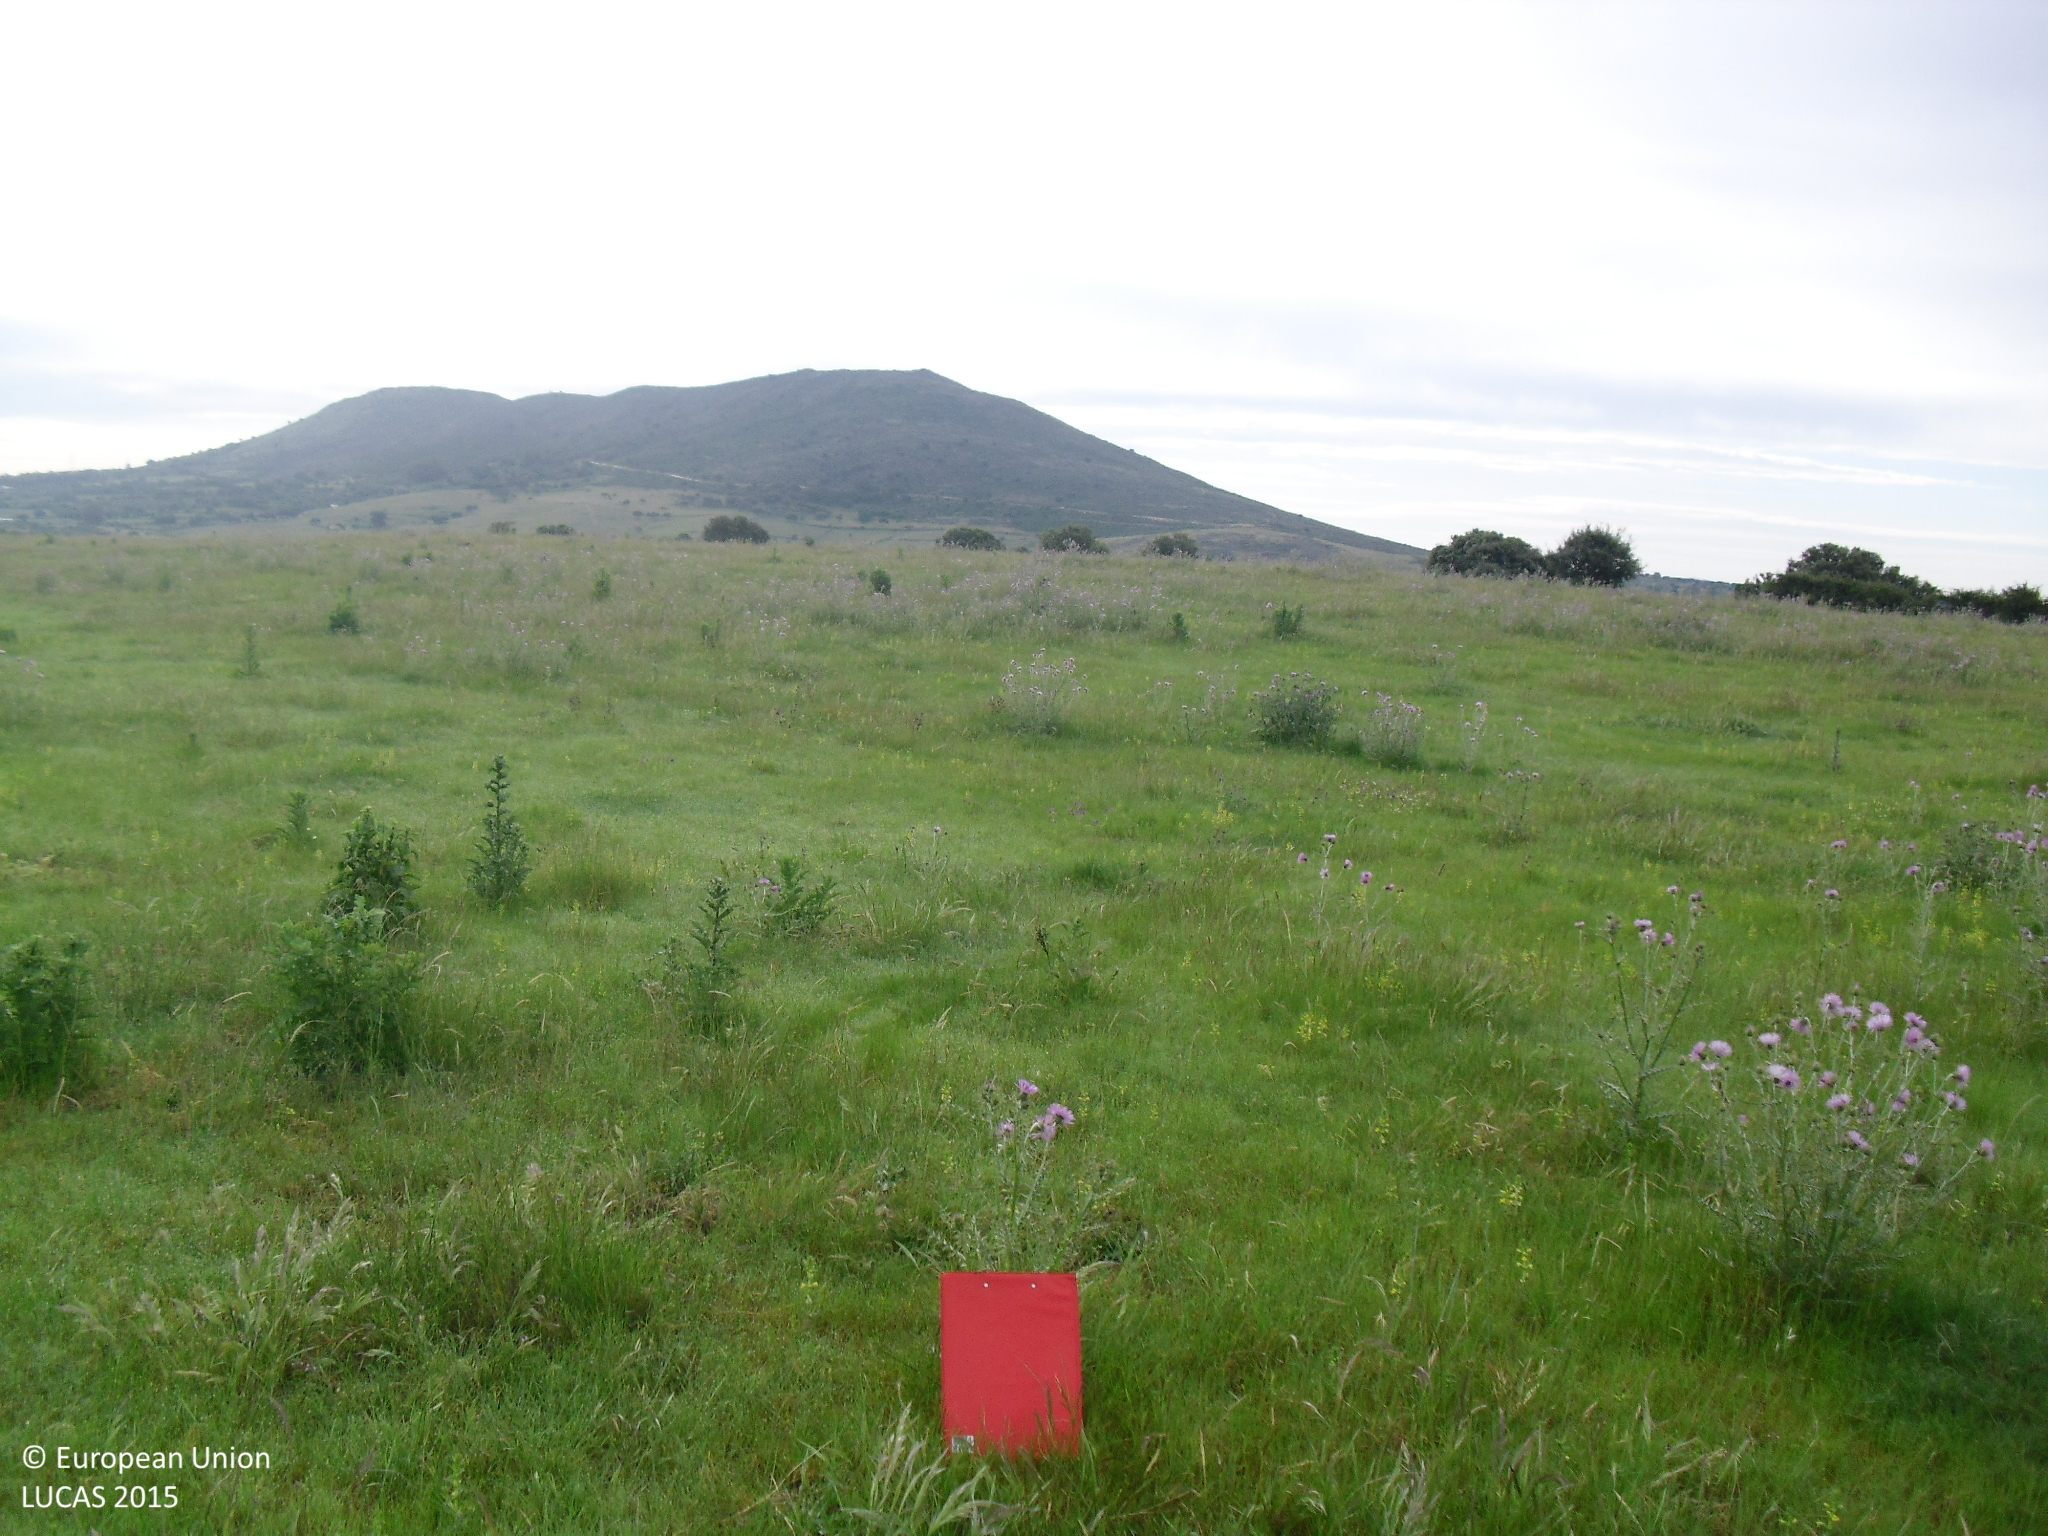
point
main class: Grassland
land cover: Grassland without tree/shrub cover
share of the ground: > 75 %
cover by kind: herbaceous plants 100 %
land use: Agriculture (excluding fallow land and kitchen gardens)
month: May
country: ES
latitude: 39.3336
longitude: -5.5377
